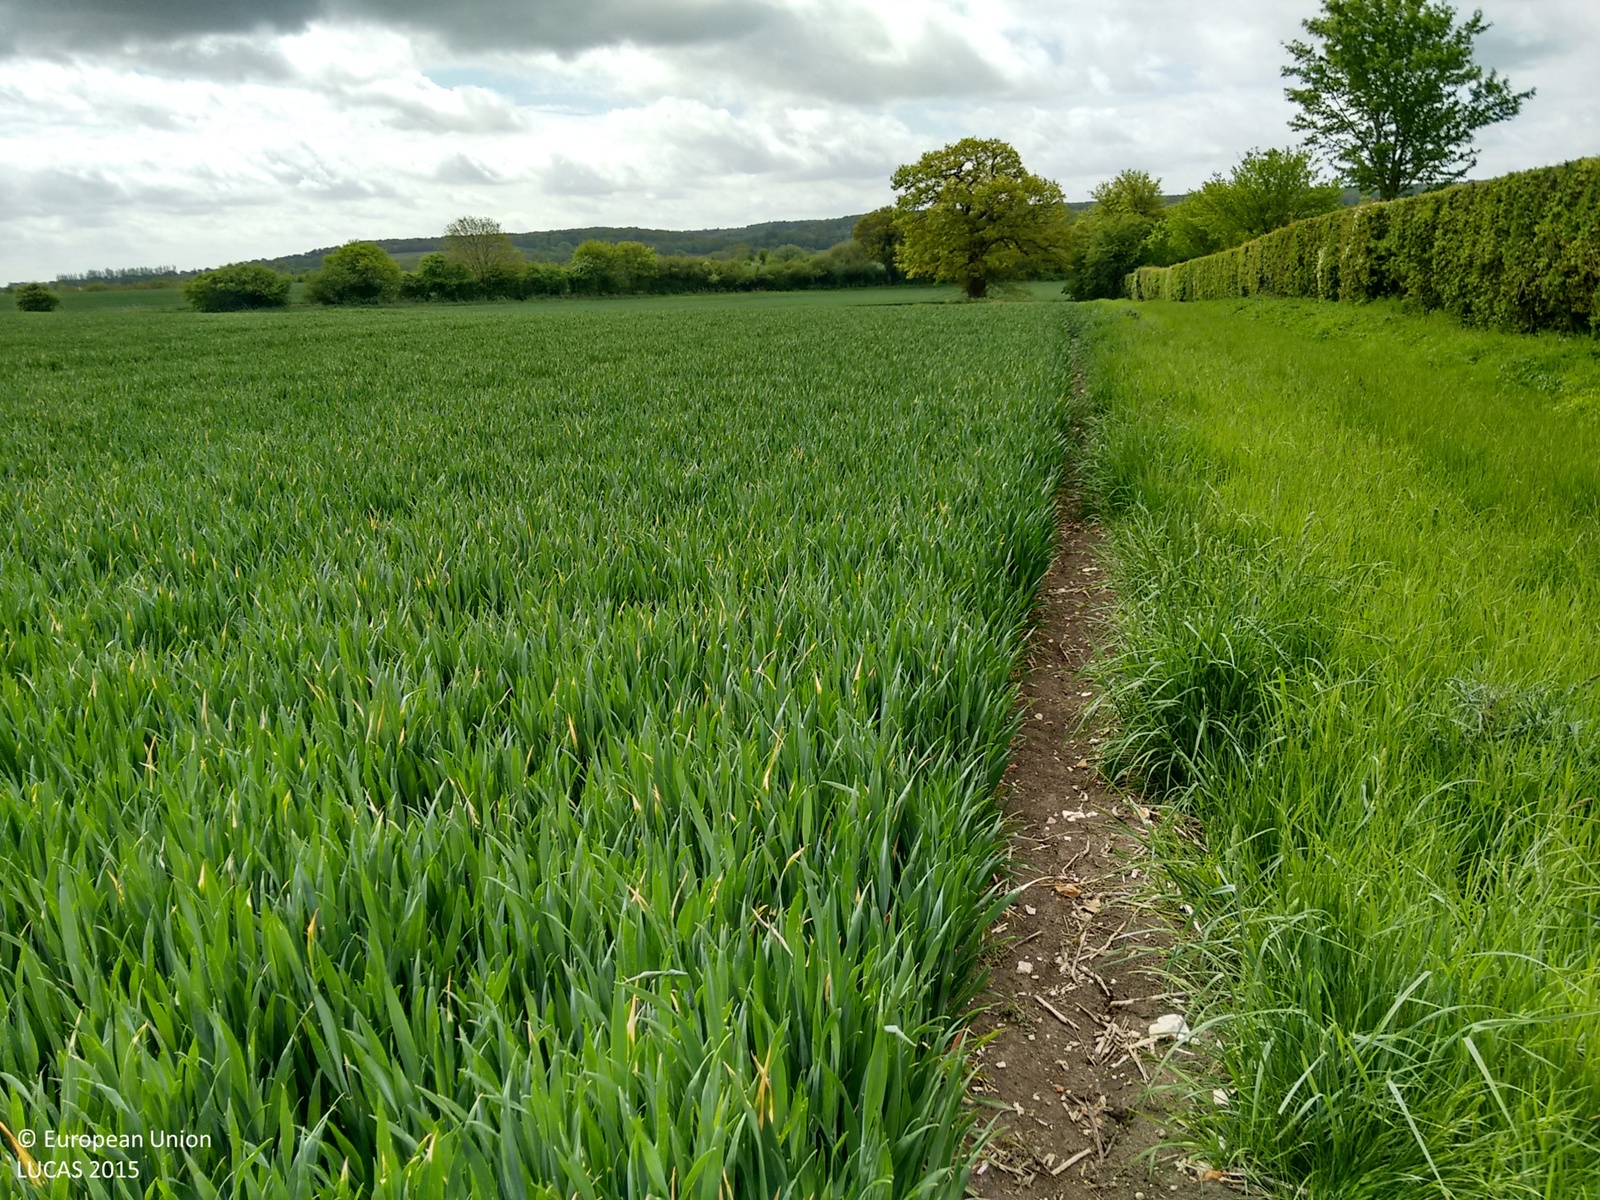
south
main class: Cropland
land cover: Common wheat
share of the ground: > 75 %
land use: Agriculture (excluding fallow land and kitchen gardens)
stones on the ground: < 10 %
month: May
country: GB
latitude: 51.3058
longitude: 0.2586
